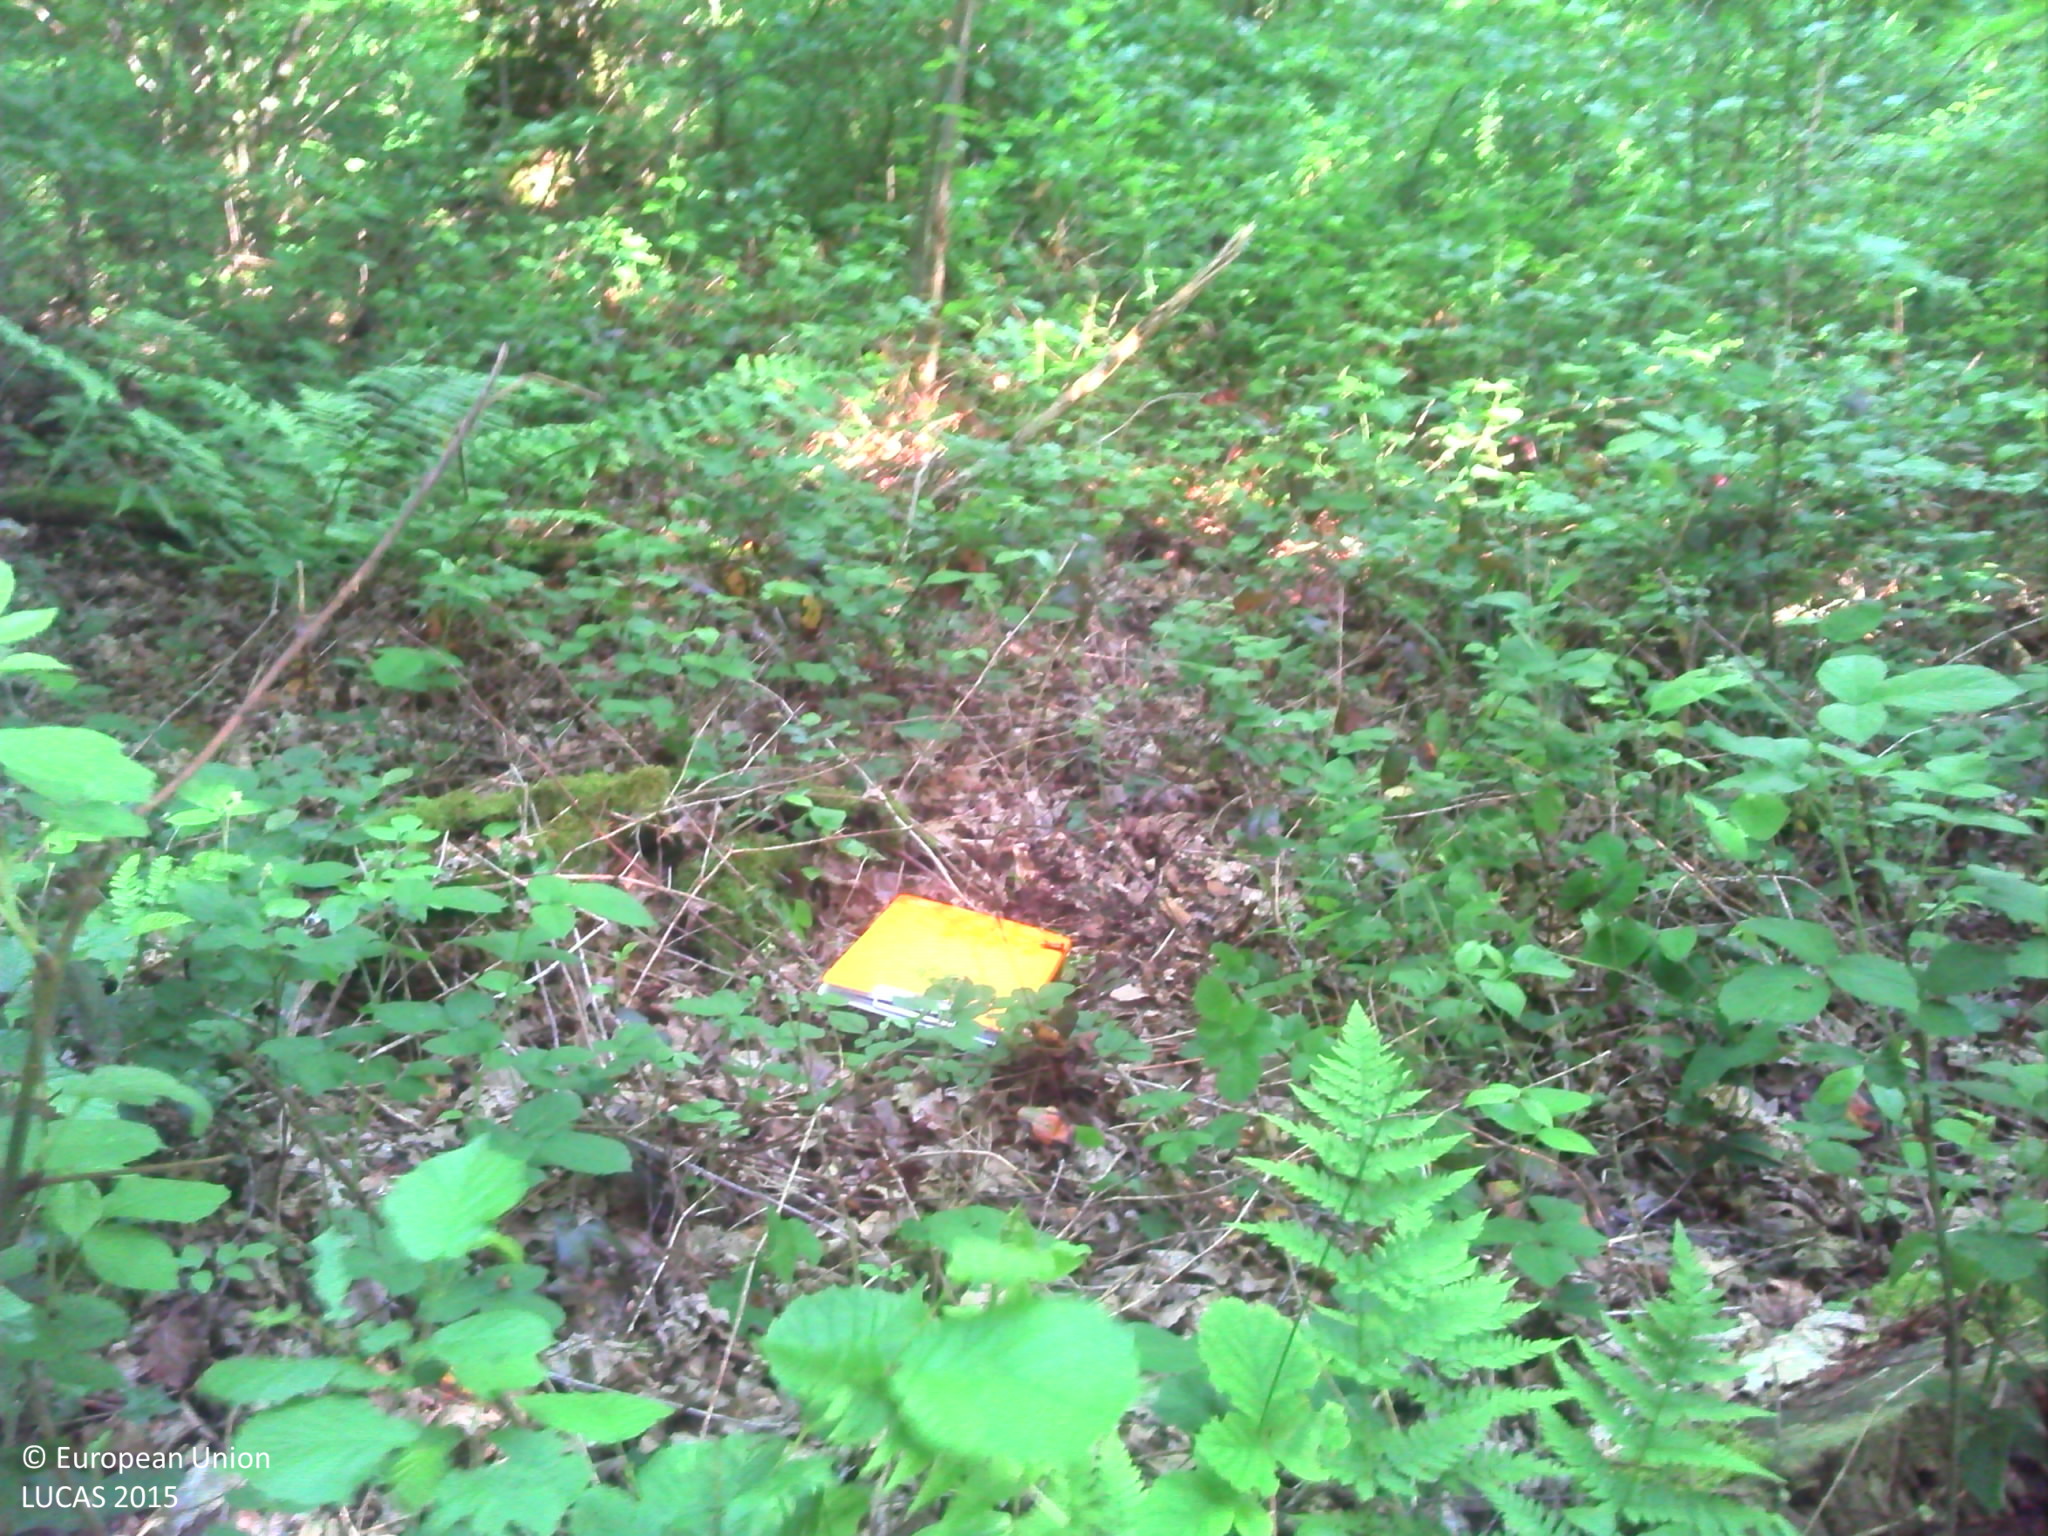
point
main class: Woodland
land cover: Broadleaved woodland
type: mesophytic deciduous forest
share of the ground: > 75 %
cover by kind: broadleaved forest trees 90 %, herbaceous plants 10 %
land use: Forestry
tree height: > 5 m
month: June
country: FR
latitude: 48.5546
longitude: 4.8633
